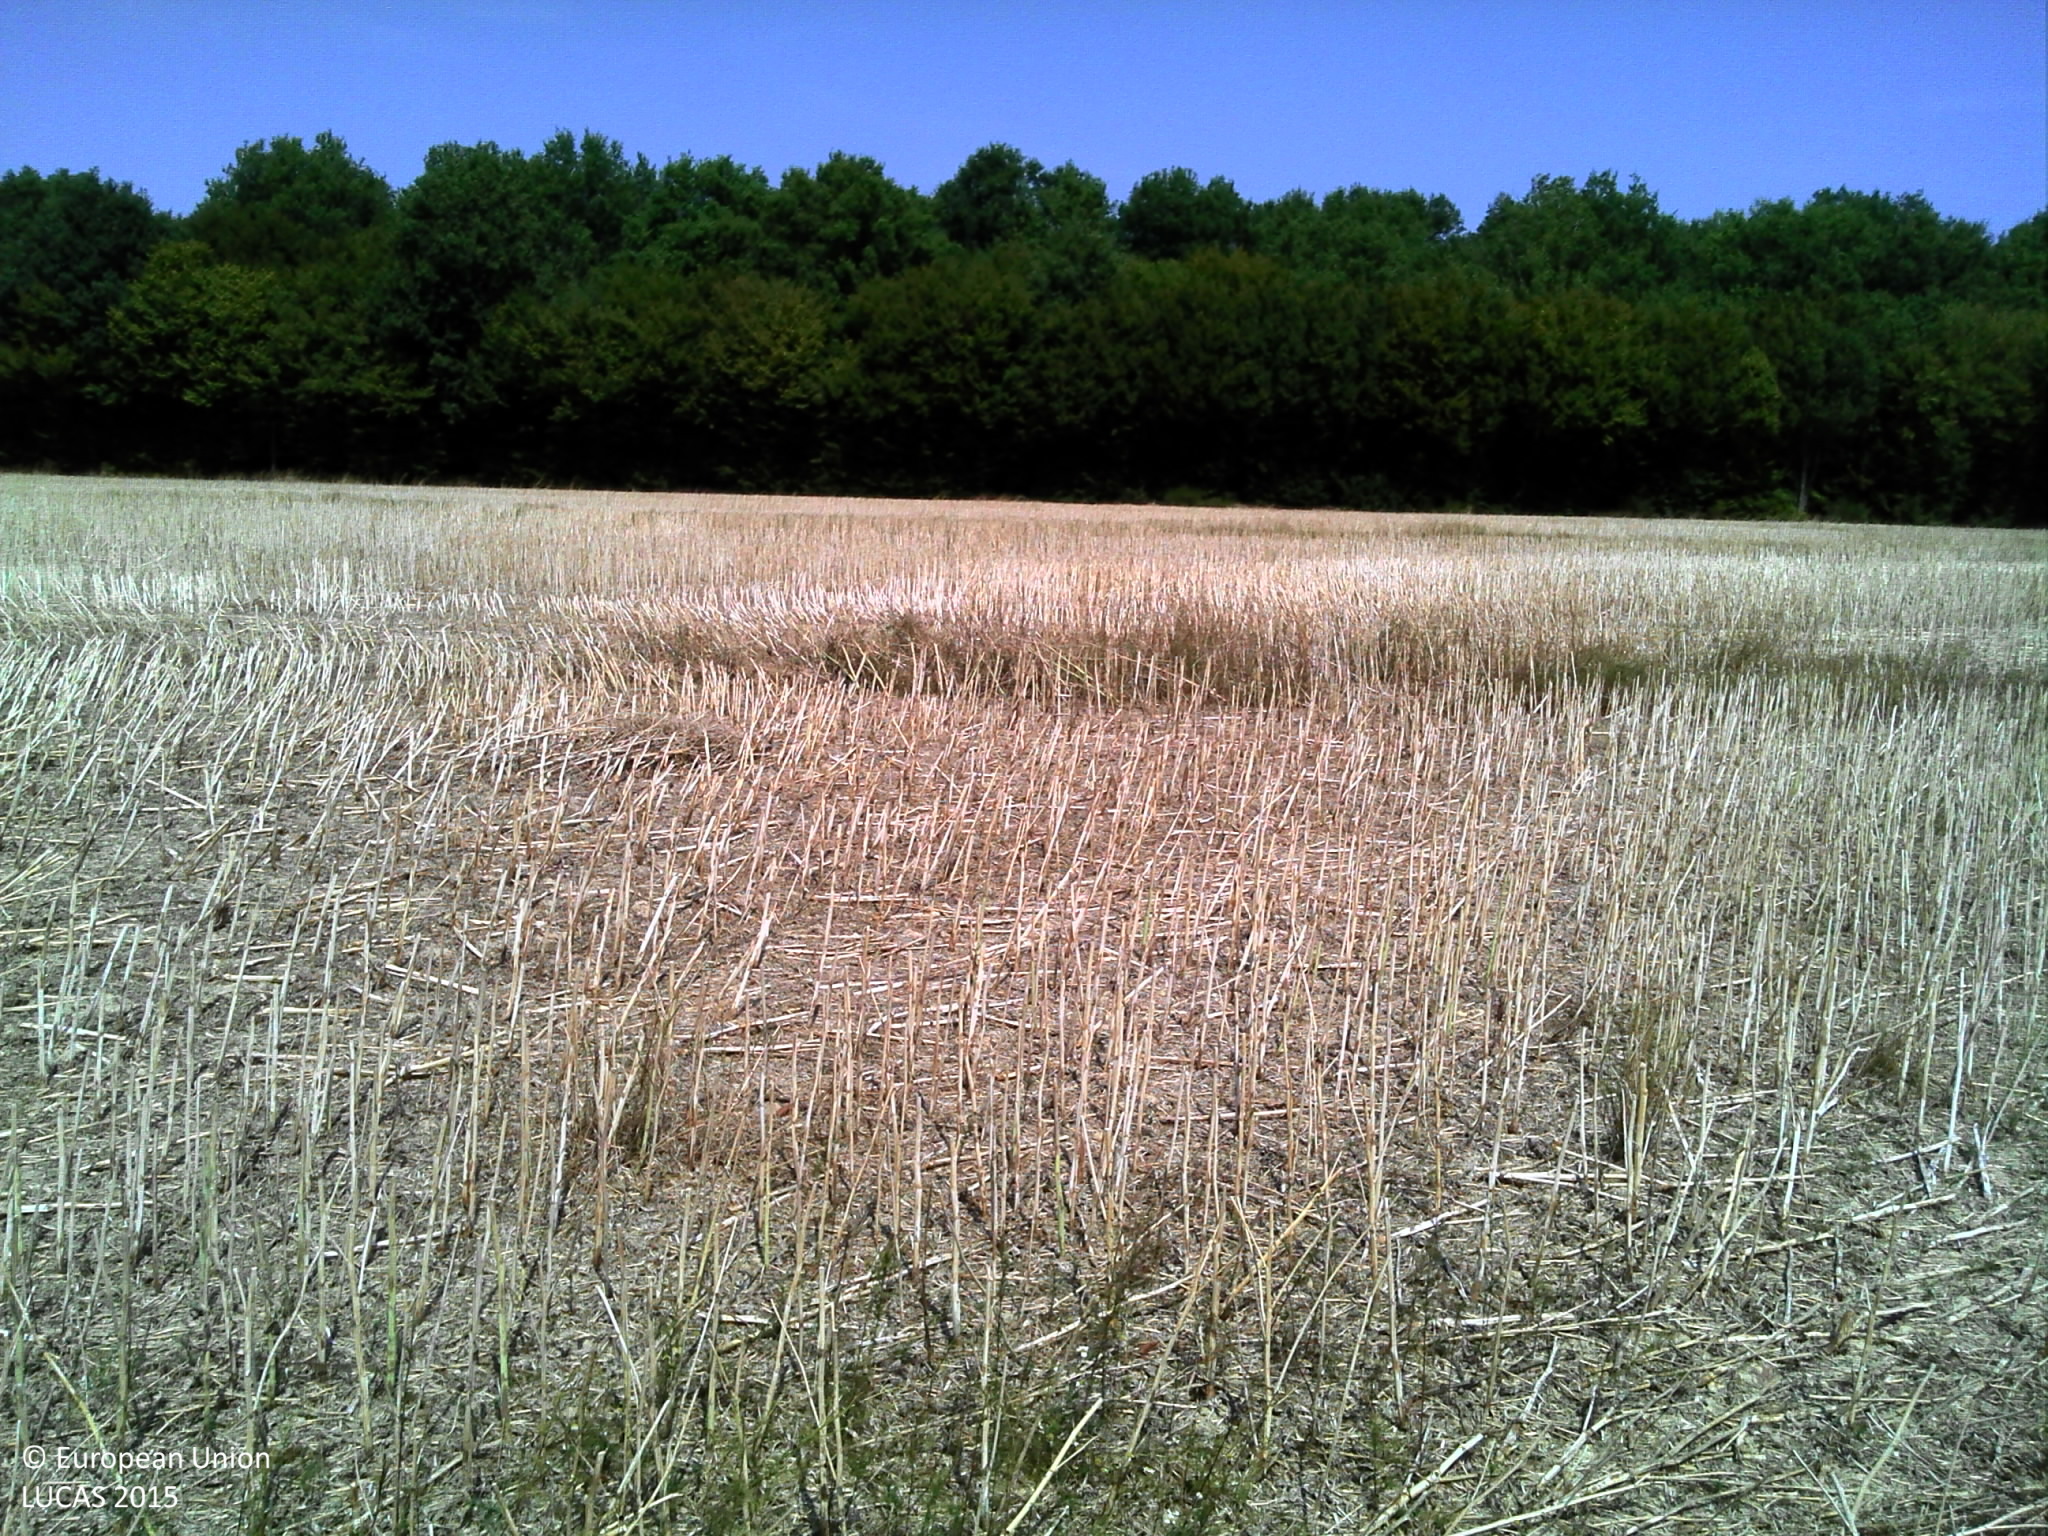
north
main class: Cropland
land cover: Rape and turnip rape
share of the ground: > 75 %
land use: Agriculture (excluding fallow land and kitchen gardens)
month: August
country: FR
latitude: 47.7543
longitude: 3.0974
